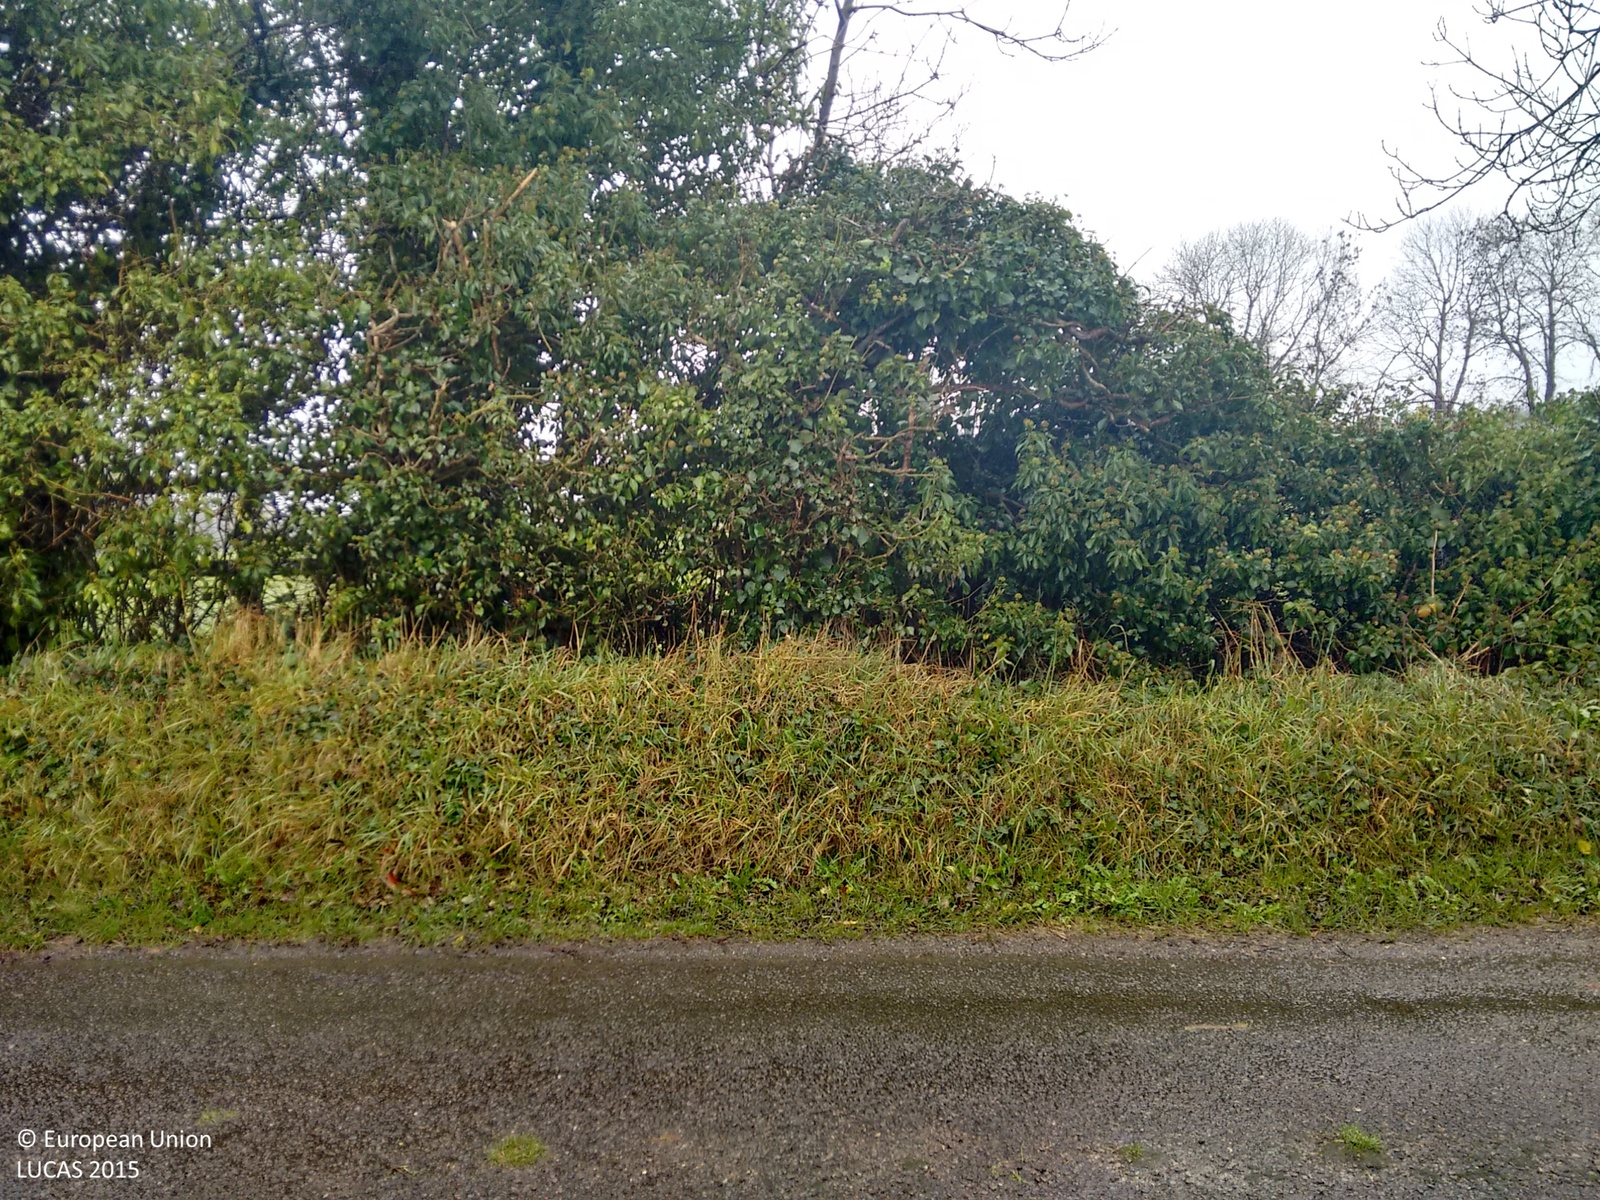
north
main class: Grassland
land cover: Grassland without tree/shrub cover
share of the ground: > 75 %
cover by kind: herbaceous plants 100 %
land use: Agriculture (excluding fallow land and kitchen gardens)
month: November
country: IE
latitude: 53.9232
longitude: -7.8483
